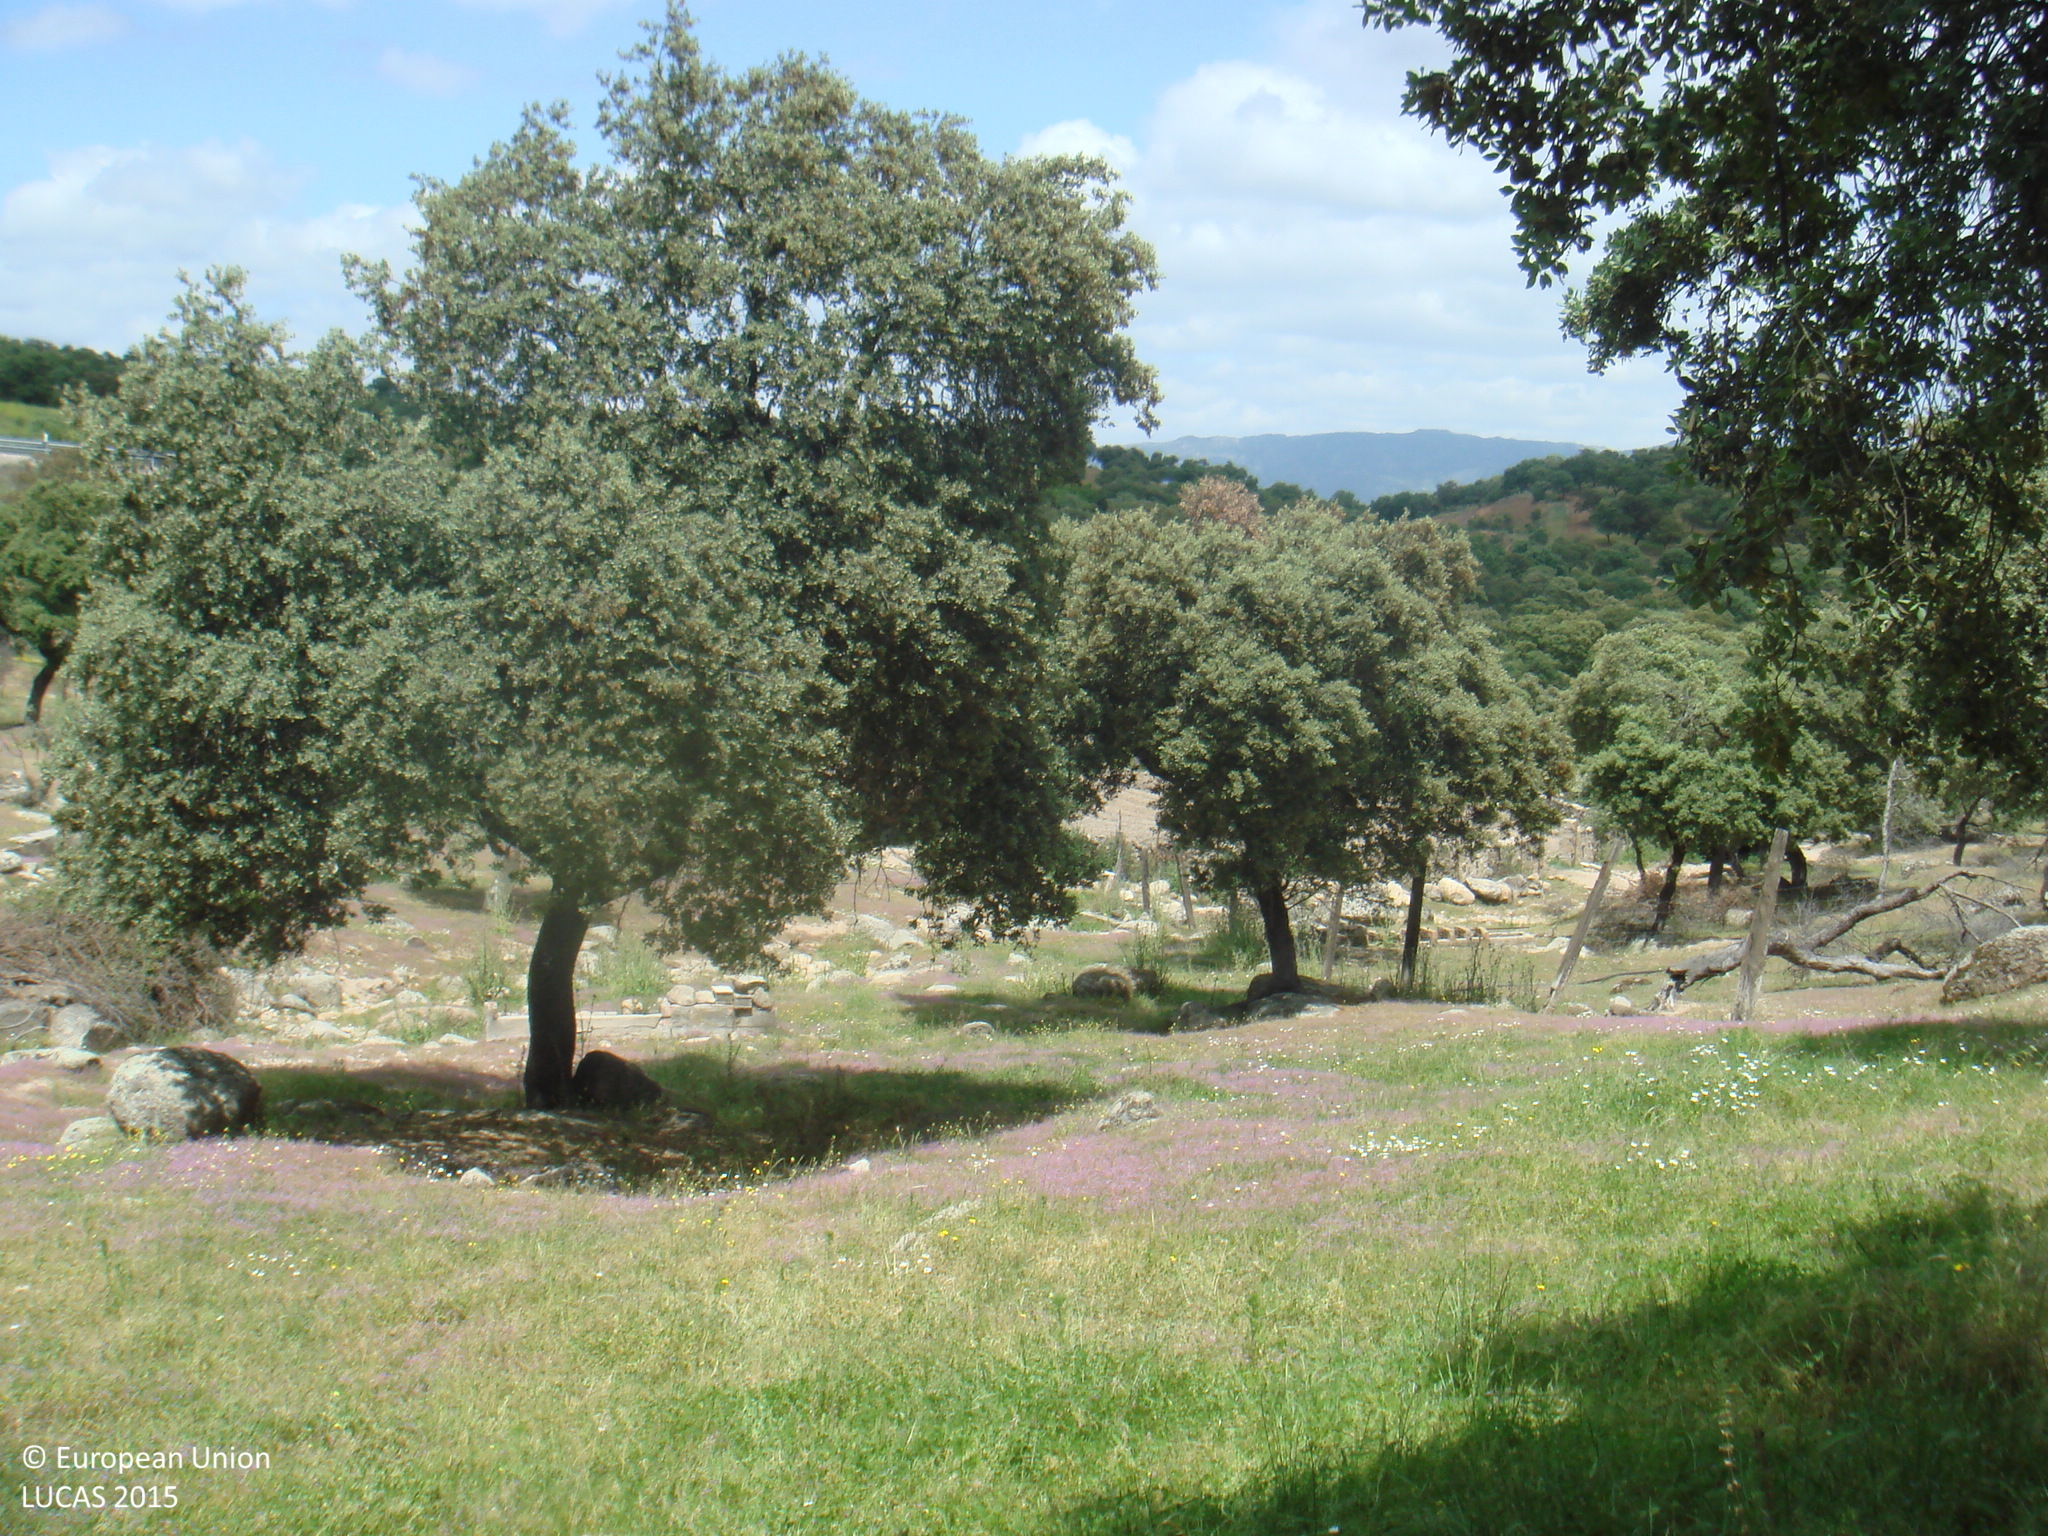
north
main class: Woodland
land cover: Broadleaved woodland
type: broadleaved evergreen forest
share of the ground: 50 - 75 %
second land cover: Spontaneously vegetated surfaces
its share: > 75 %
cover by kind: herbaceous plants 60 %, broadleaved forest trees 40 %
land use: Forestry
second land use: Agriculture (excluding fallow land and kitchen gardens)
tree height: > 5 m
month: May
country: ES
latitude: 38.3111
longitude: -4.3224
